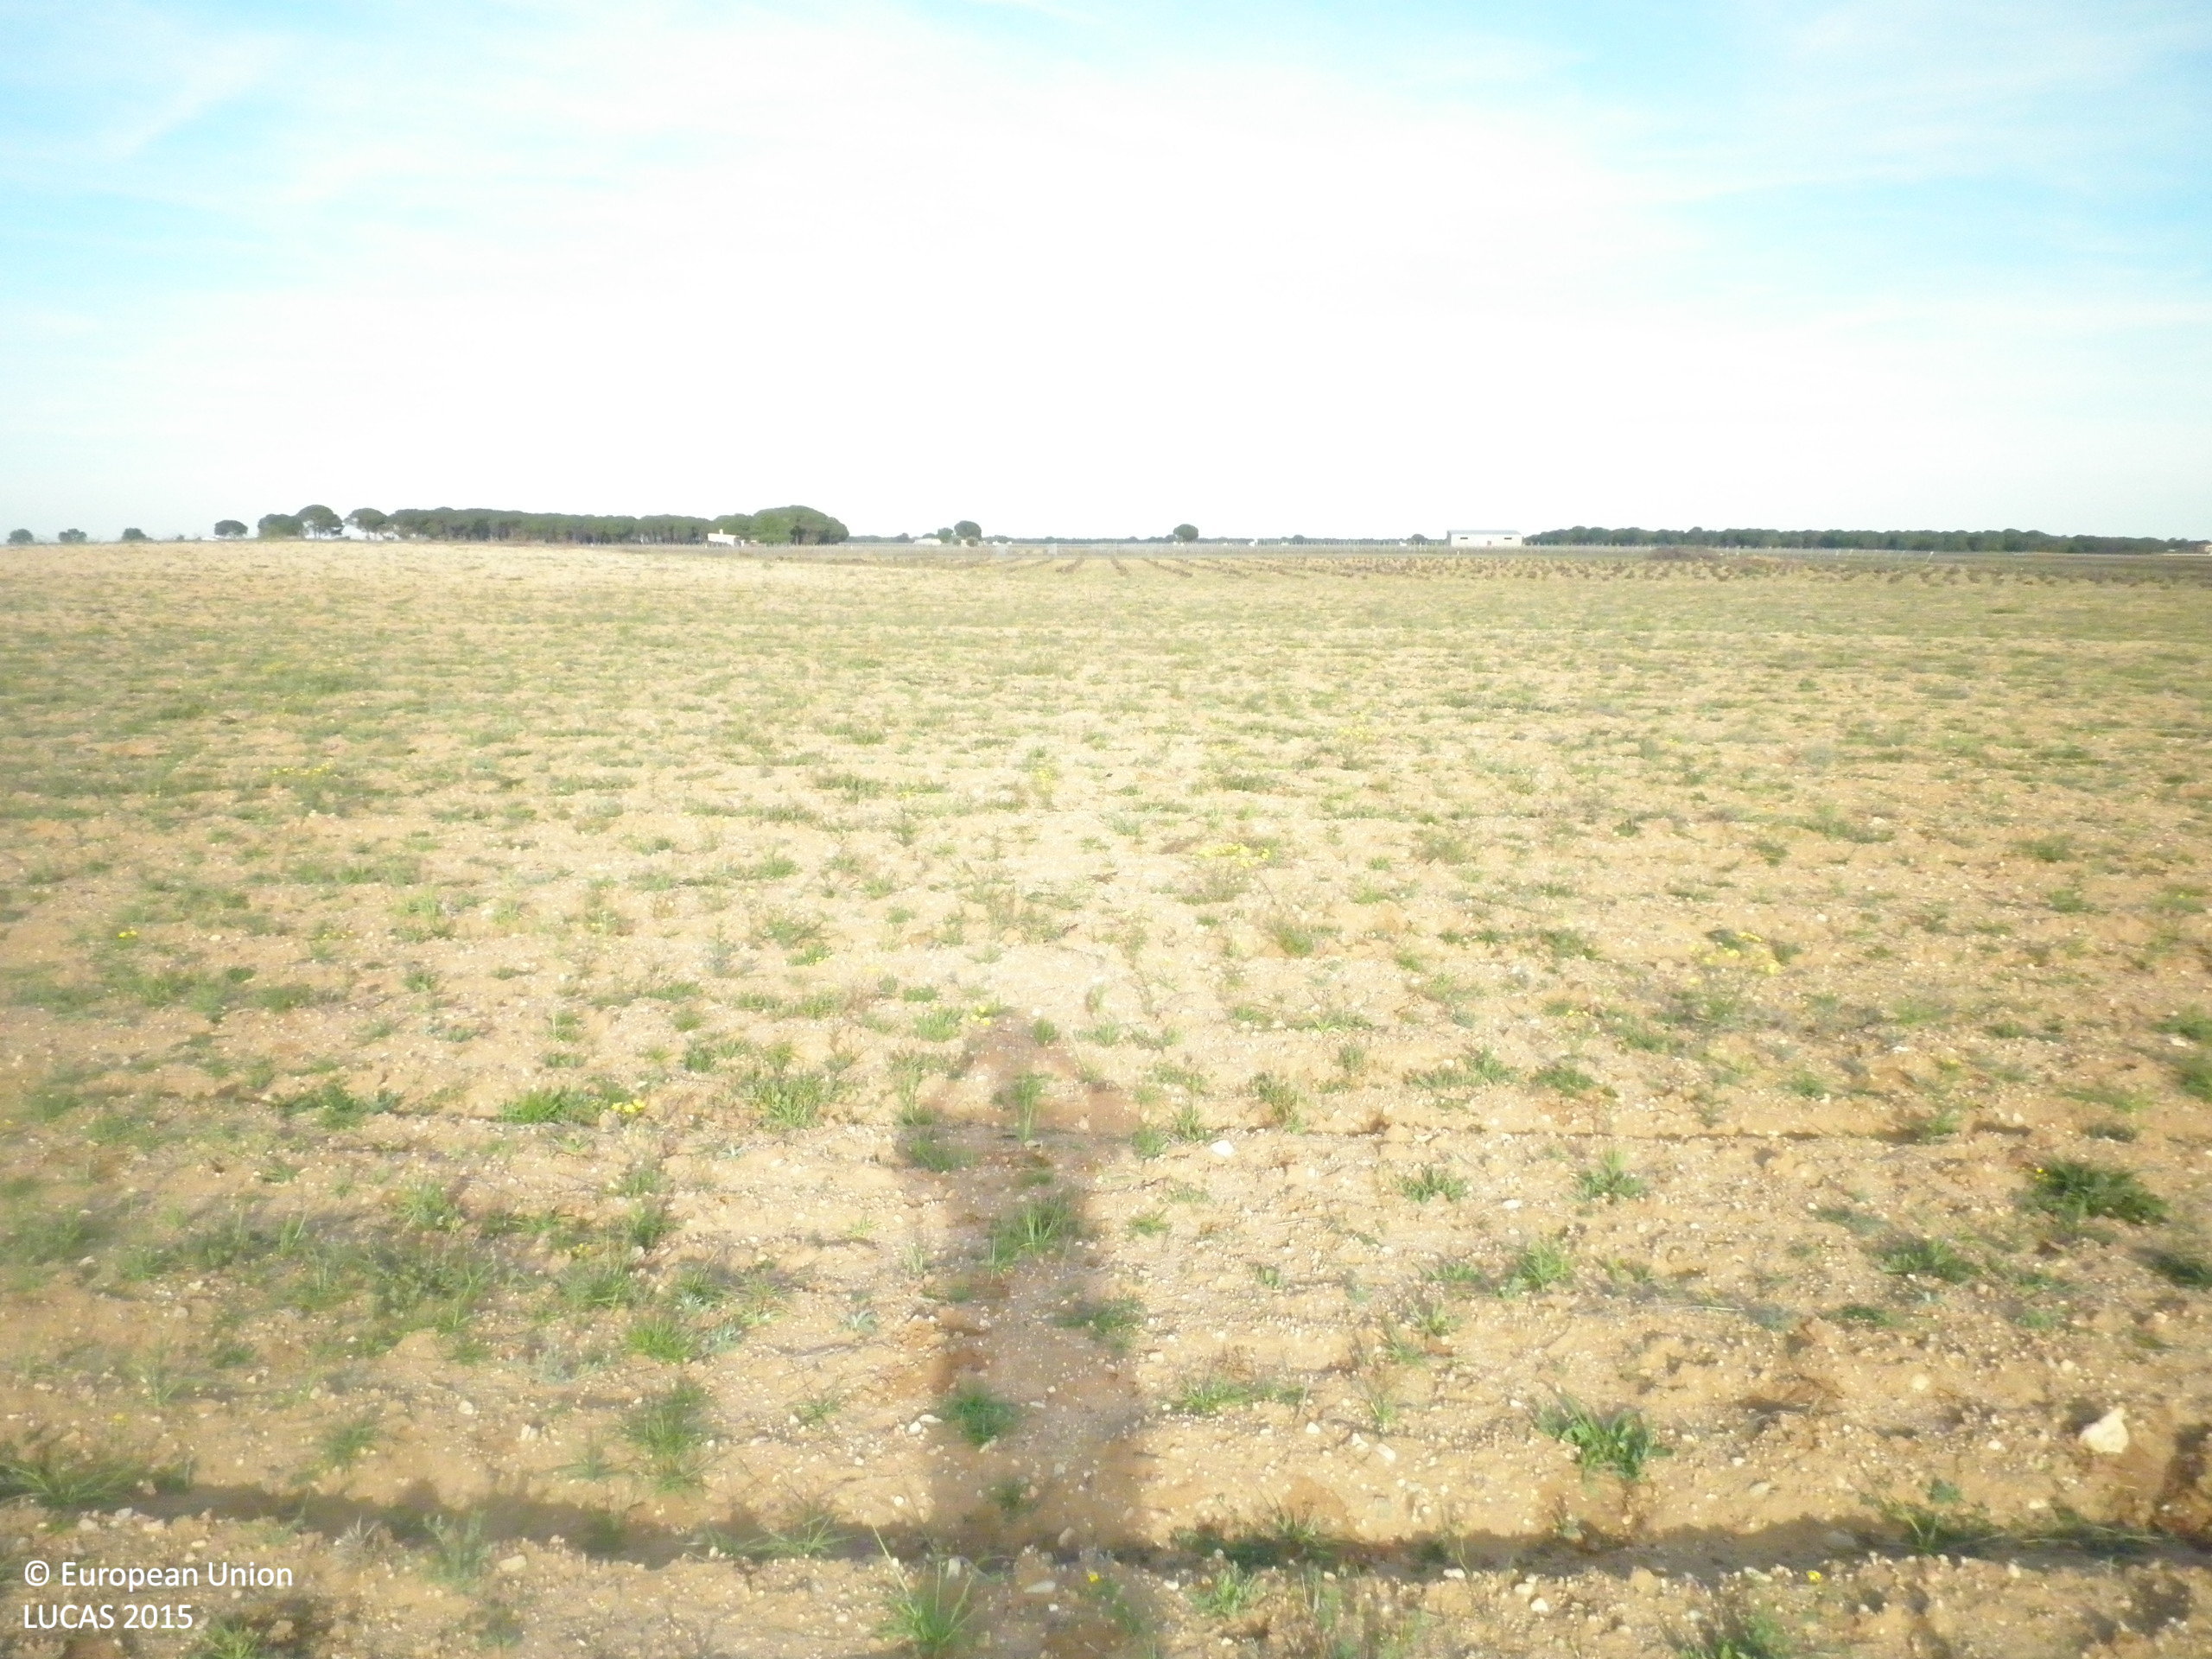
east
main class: Grassland
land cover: Spontaneously vegetated surfaces
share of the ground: 10 - 25 %
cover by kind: unconsolidated bare surface 75 %, herbaceous plants 25 %
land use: Fallow land
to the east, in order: Spontaneously vegetated surfaces; Vineyards; Spontaneously vegetated surfaces; Vineyards
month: April
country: ES
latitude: 39.3385
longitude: -2.7633
